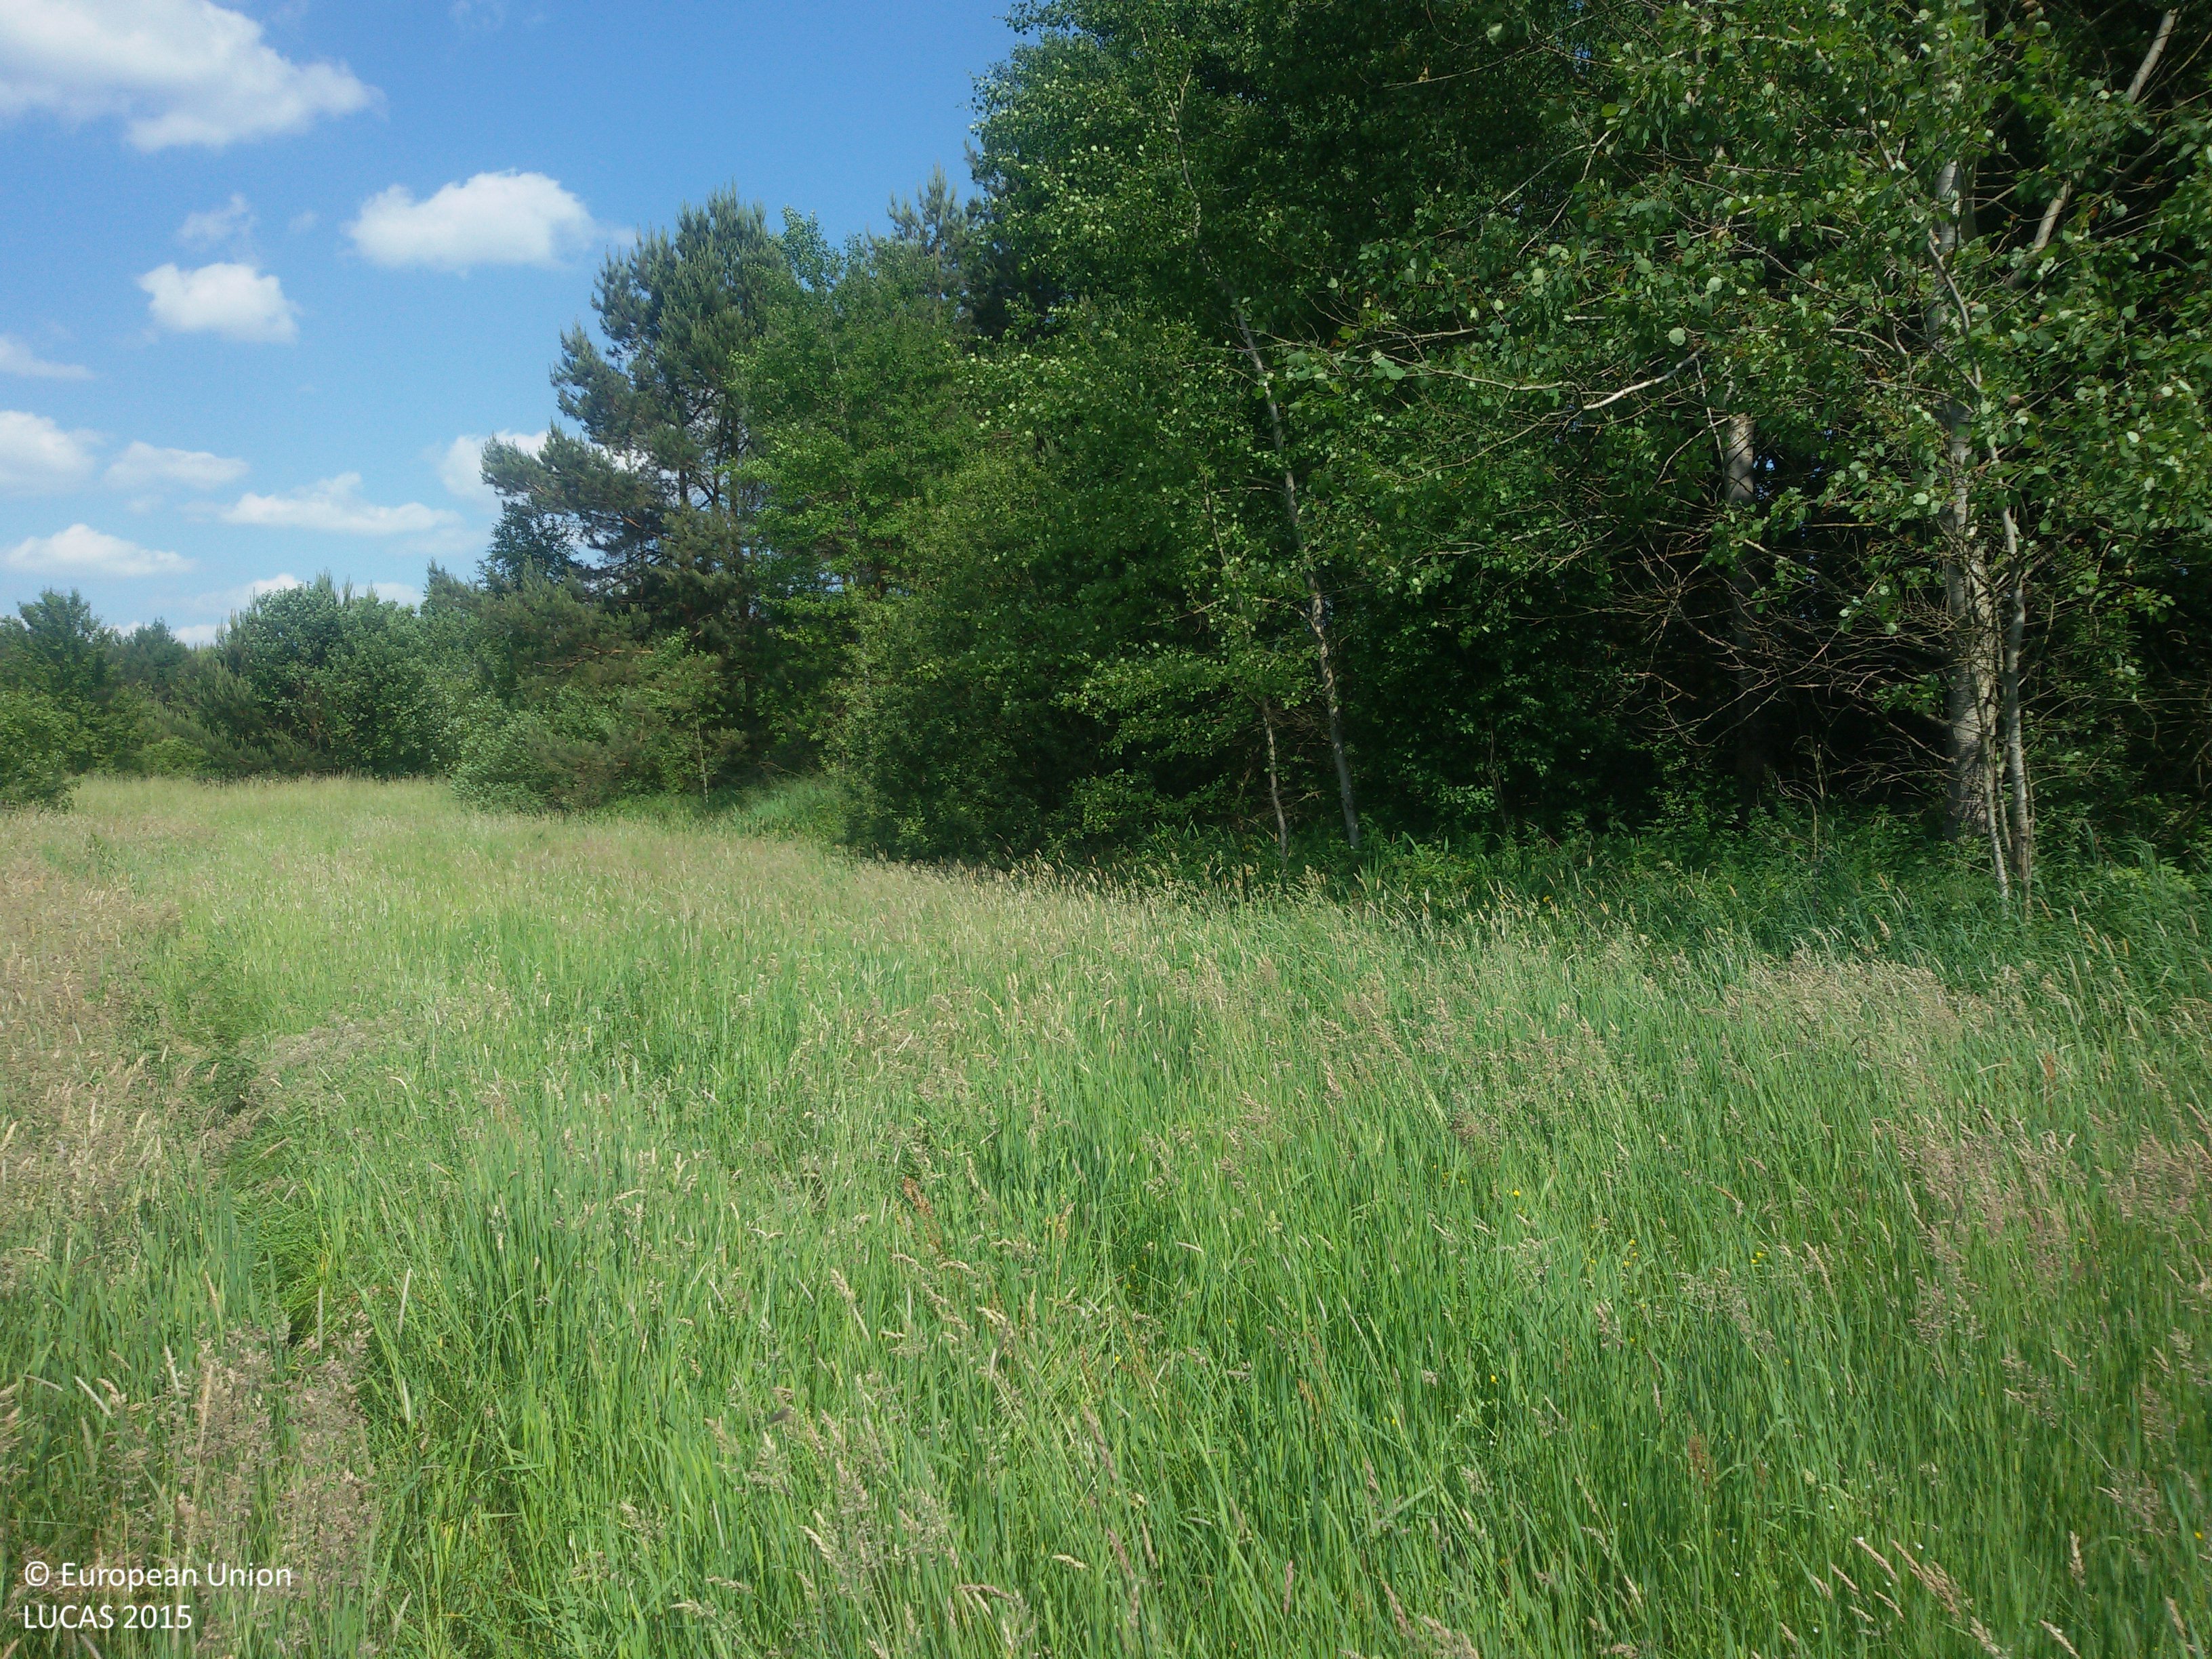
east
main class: Grassland
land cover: Grassland without tree/shrub cover
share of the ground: > 75 %
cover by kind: herbaceous plants 100 %
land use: Agriculture (excluding fallow land and kitchen gardens)
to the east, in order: Grassland without tree/shrub cover; Broadleaved woodland; Grassland without tree/shrub cover; Ditches and canals; Grassland without tree/shrub cover; Shrubland with sparse tree cover
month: June
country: PL
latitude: 51.5703
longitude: 22.8115
